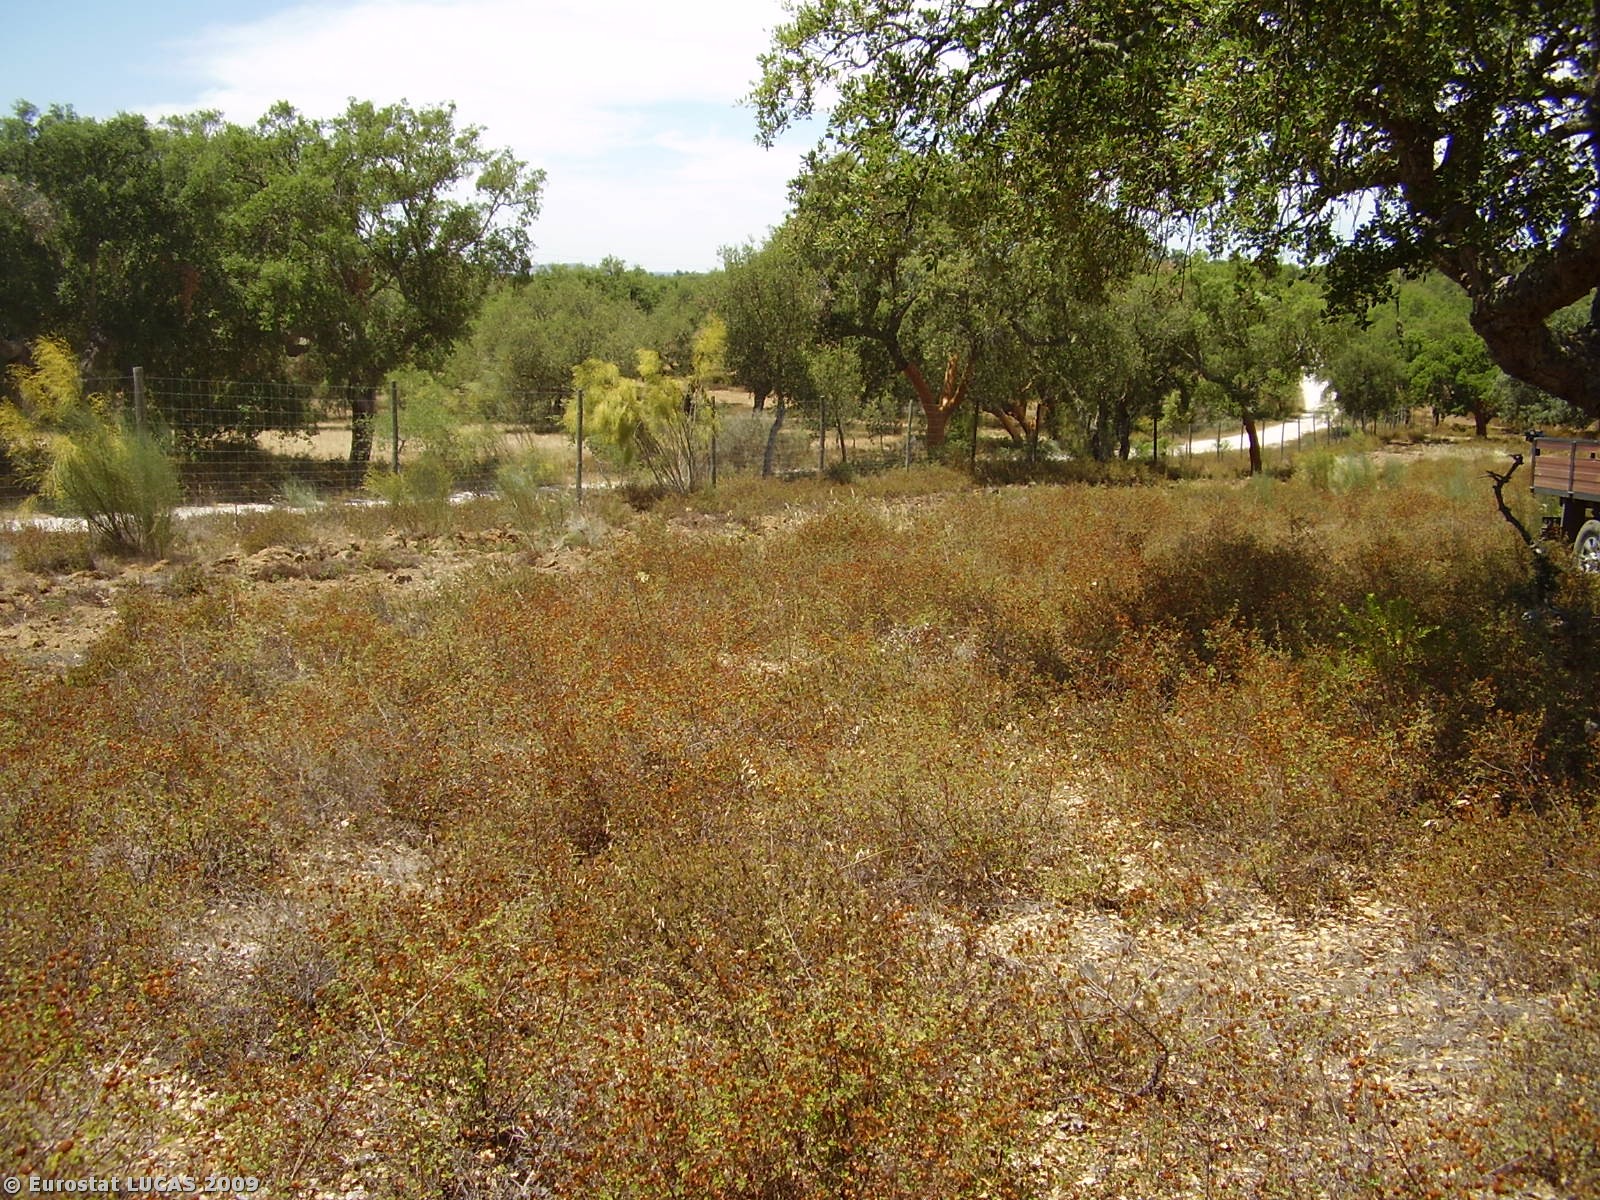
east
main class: Woodland
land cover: Broadleaved woodland
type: broadleaved evergreen forest
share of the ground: 10 - 25 %
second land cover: Spontaneously vegetated surfaces
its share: 50 - 75 %
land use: Forestry
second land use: Fallow land
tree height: > 5 m
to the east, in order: Broadleaved woodland; Spontaneously vegetated surfaces; Broadleaved woodland; Fences; Broadleaved woodland; Spontaneously vegetated surfaces; Single bushes/trees; Spontaneously vegetated surfaces
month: July
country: PT
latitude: 38.7247
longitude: -7.8582
